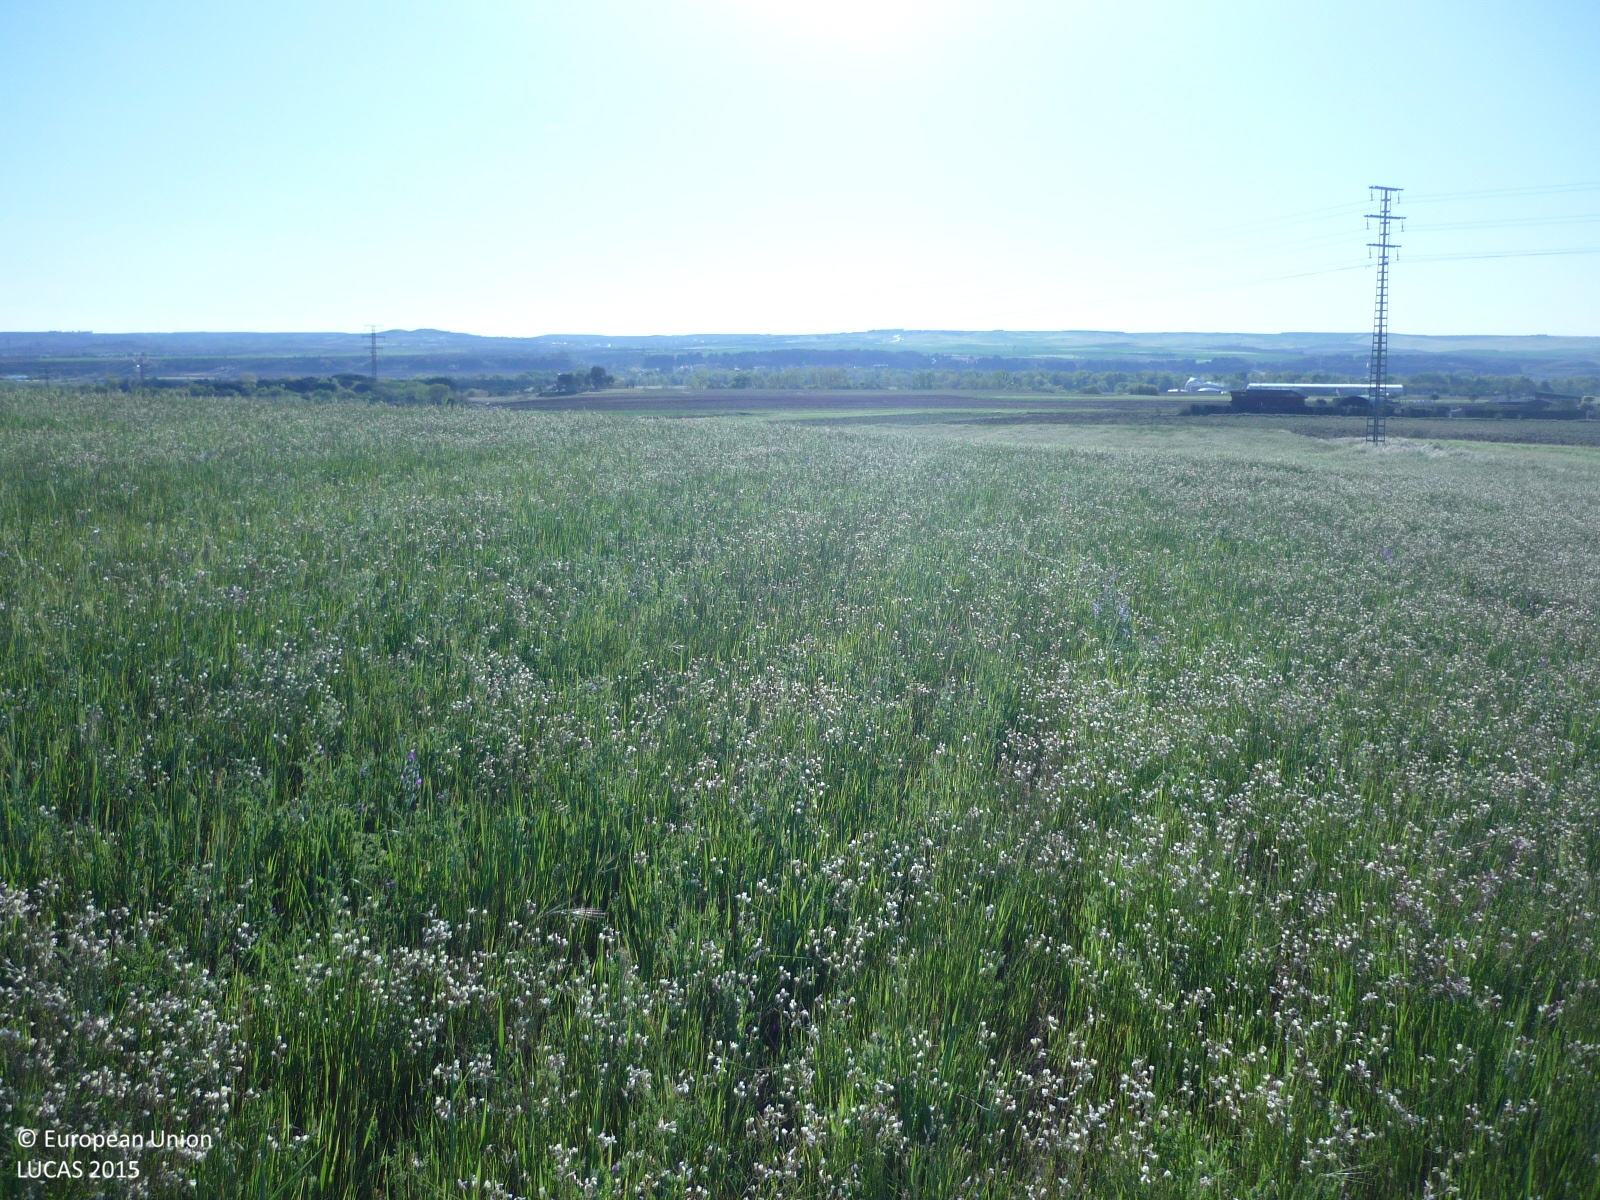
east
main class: Grassland
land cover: Spontaneously vegetated surfaces
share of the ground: > 75 %
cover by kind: herbaceous plants 90 %, unconsolidated bare surface 10 %
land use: Fallow land
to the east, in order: Spontaneously vegetated surfaces; Electric lines; Spontaneously vegetated surfaces; Grass margins; Other bare soil; Grass margins; Common wheat; Grass margins; Other bare soil
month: April
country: ES
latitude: 40.5630
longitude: -3.5848
